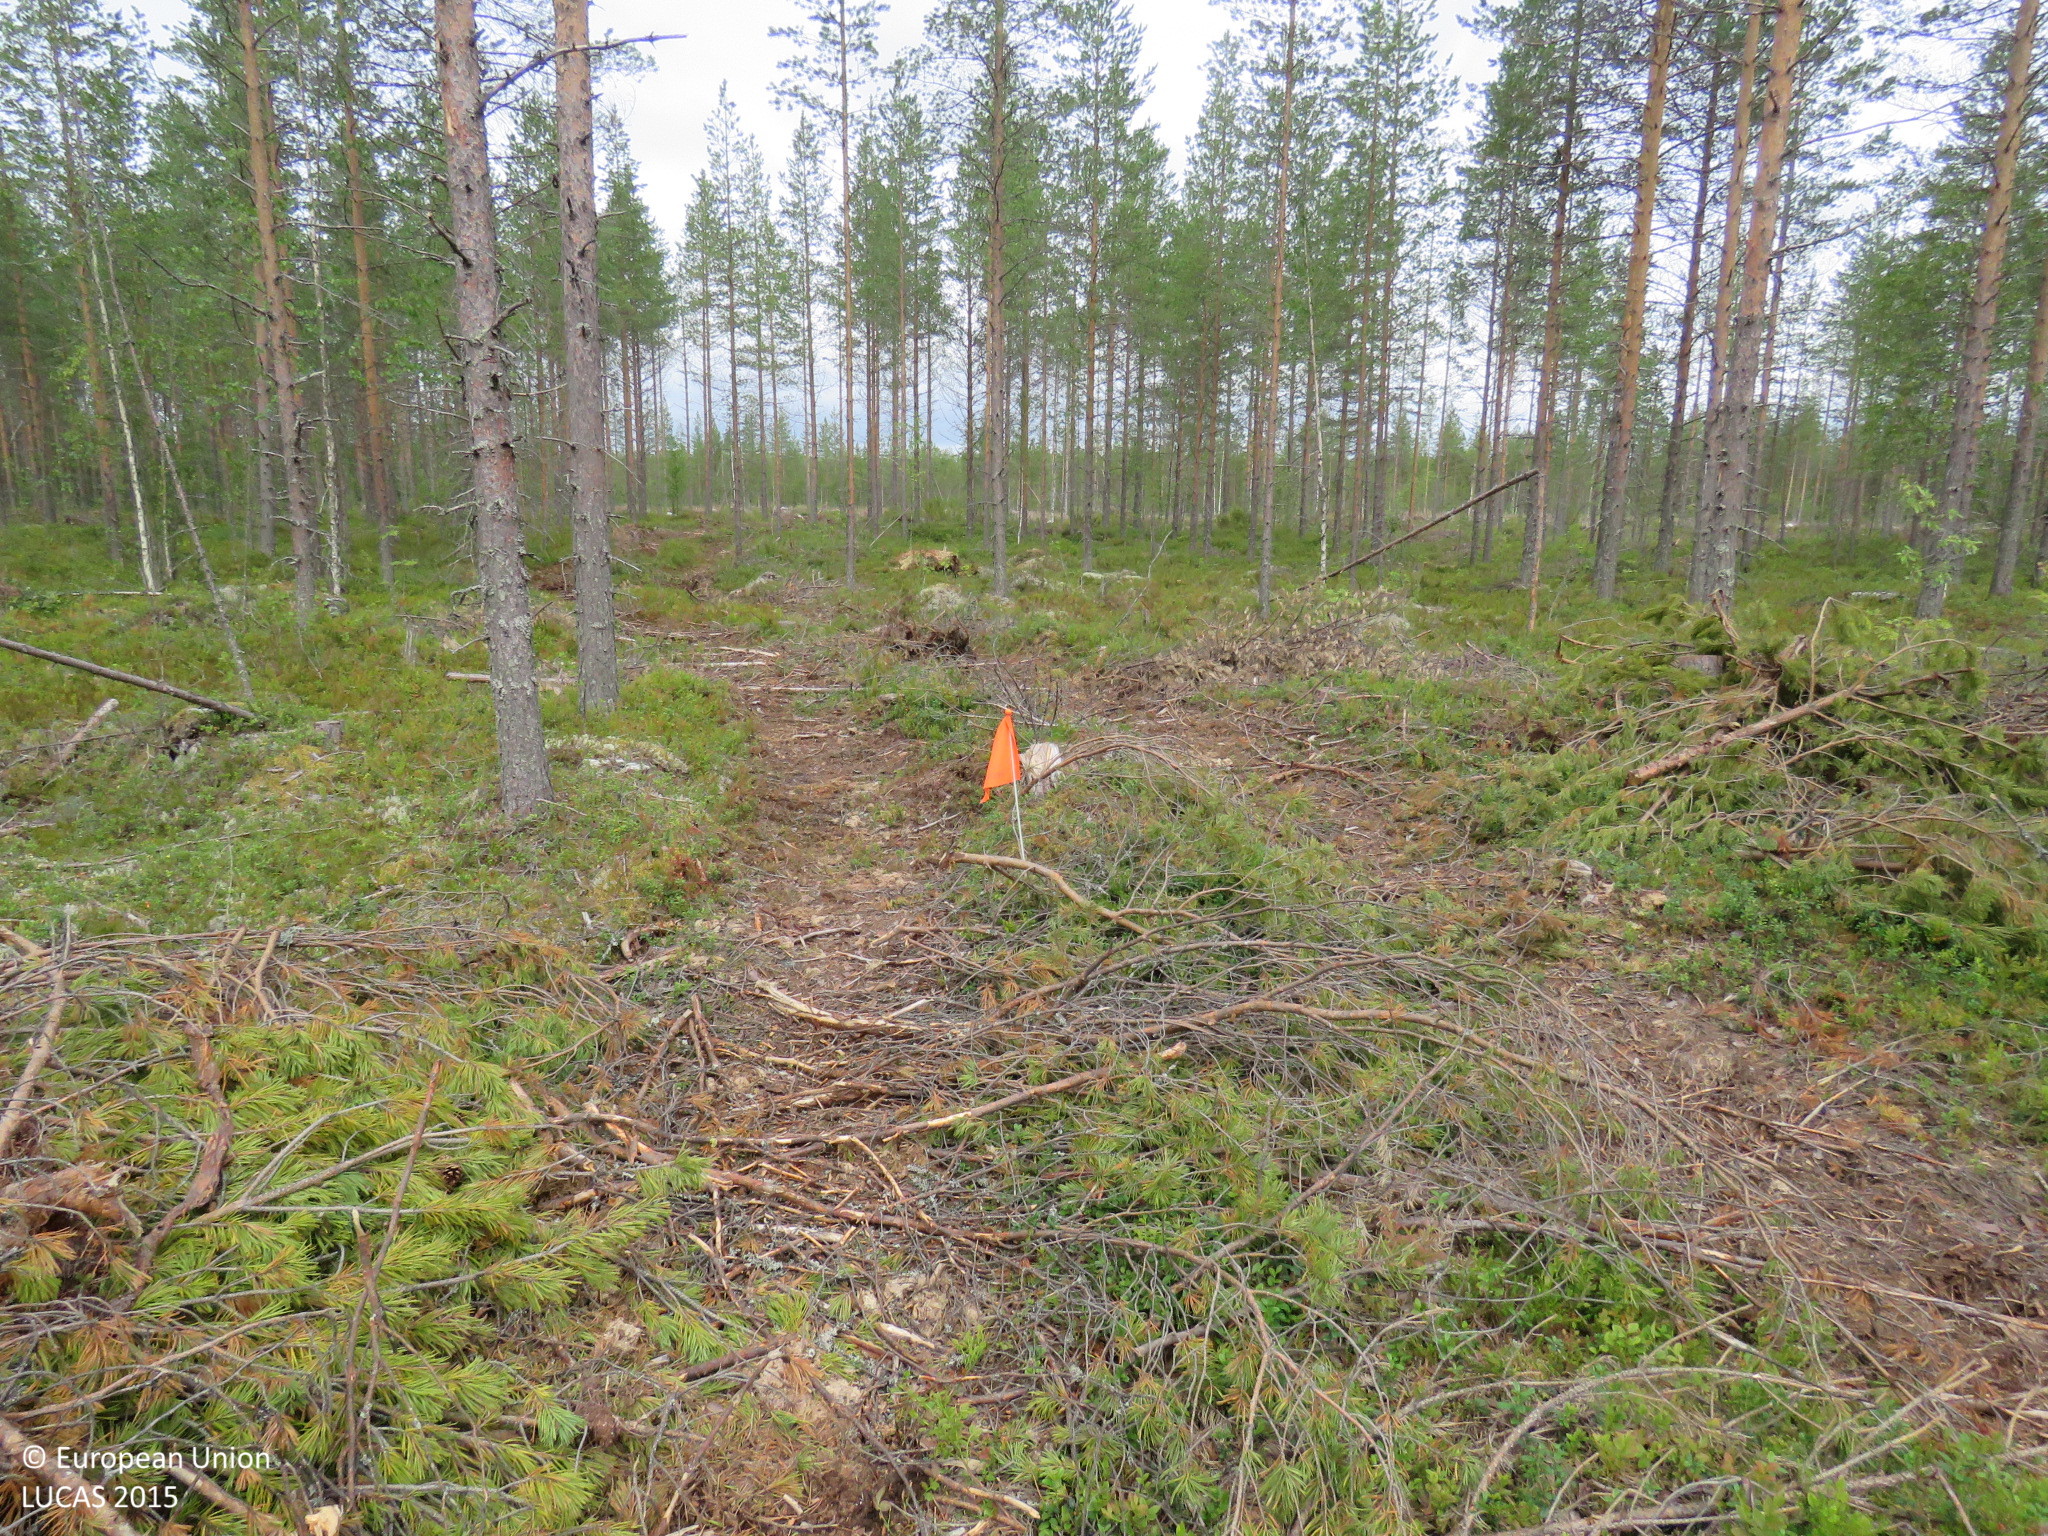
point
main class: Woodland
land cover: Pine dominated coniferous woodland
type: boreal forest
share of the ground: 50 - 75 %
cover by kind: coniferous forest trees 40 %, shrubs 40 %, broadleaved forest trees 10 %, lichens and mosses 10 %
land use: Forestry
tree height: > 5 m
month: July
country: FI
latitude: 64.6479
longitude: 26.9326
